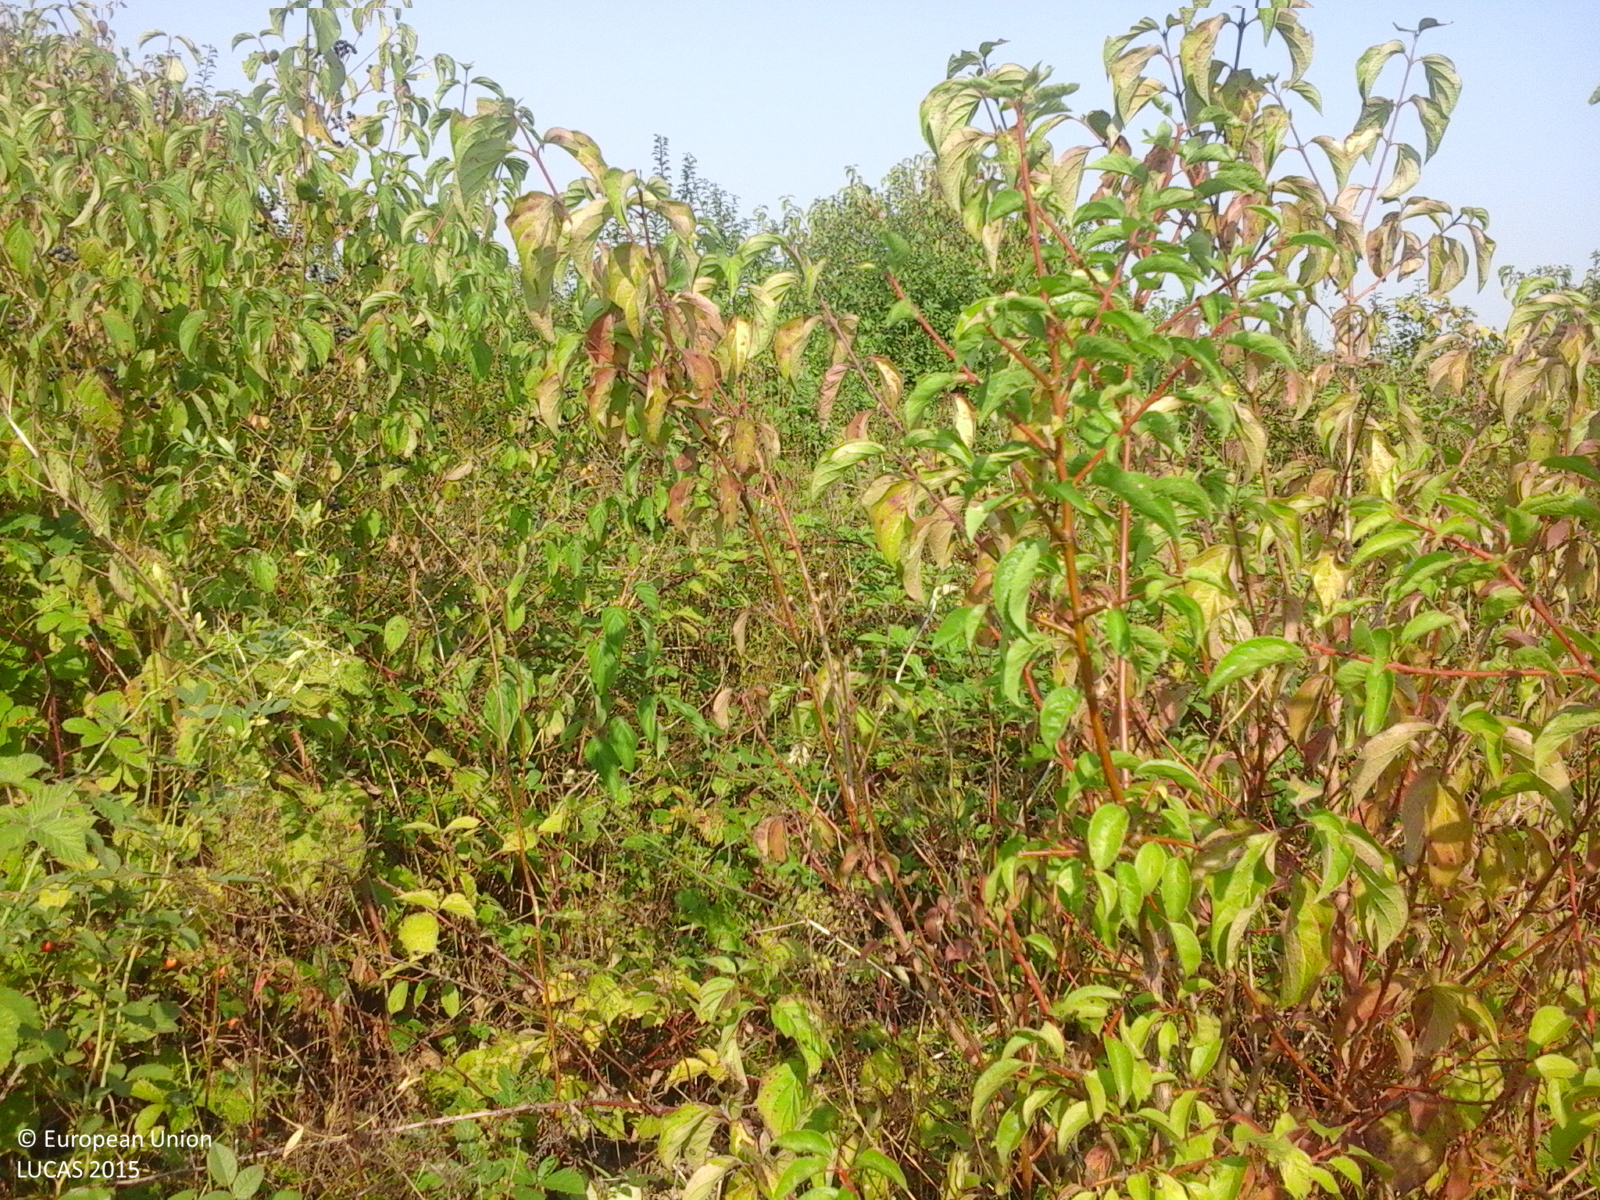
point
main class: Grassland
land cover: Grassland with sparse tree/shrub cover
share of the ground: > 75 %
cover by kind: herbaceous plants 85 %, shrubs 10 %, broadleaved forest trees 5 %
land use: Agriculture (excluding fallow land and kitchen gardens)
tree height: < 5 m
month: August
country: RO
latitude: 46.3128
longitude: 22.2930
